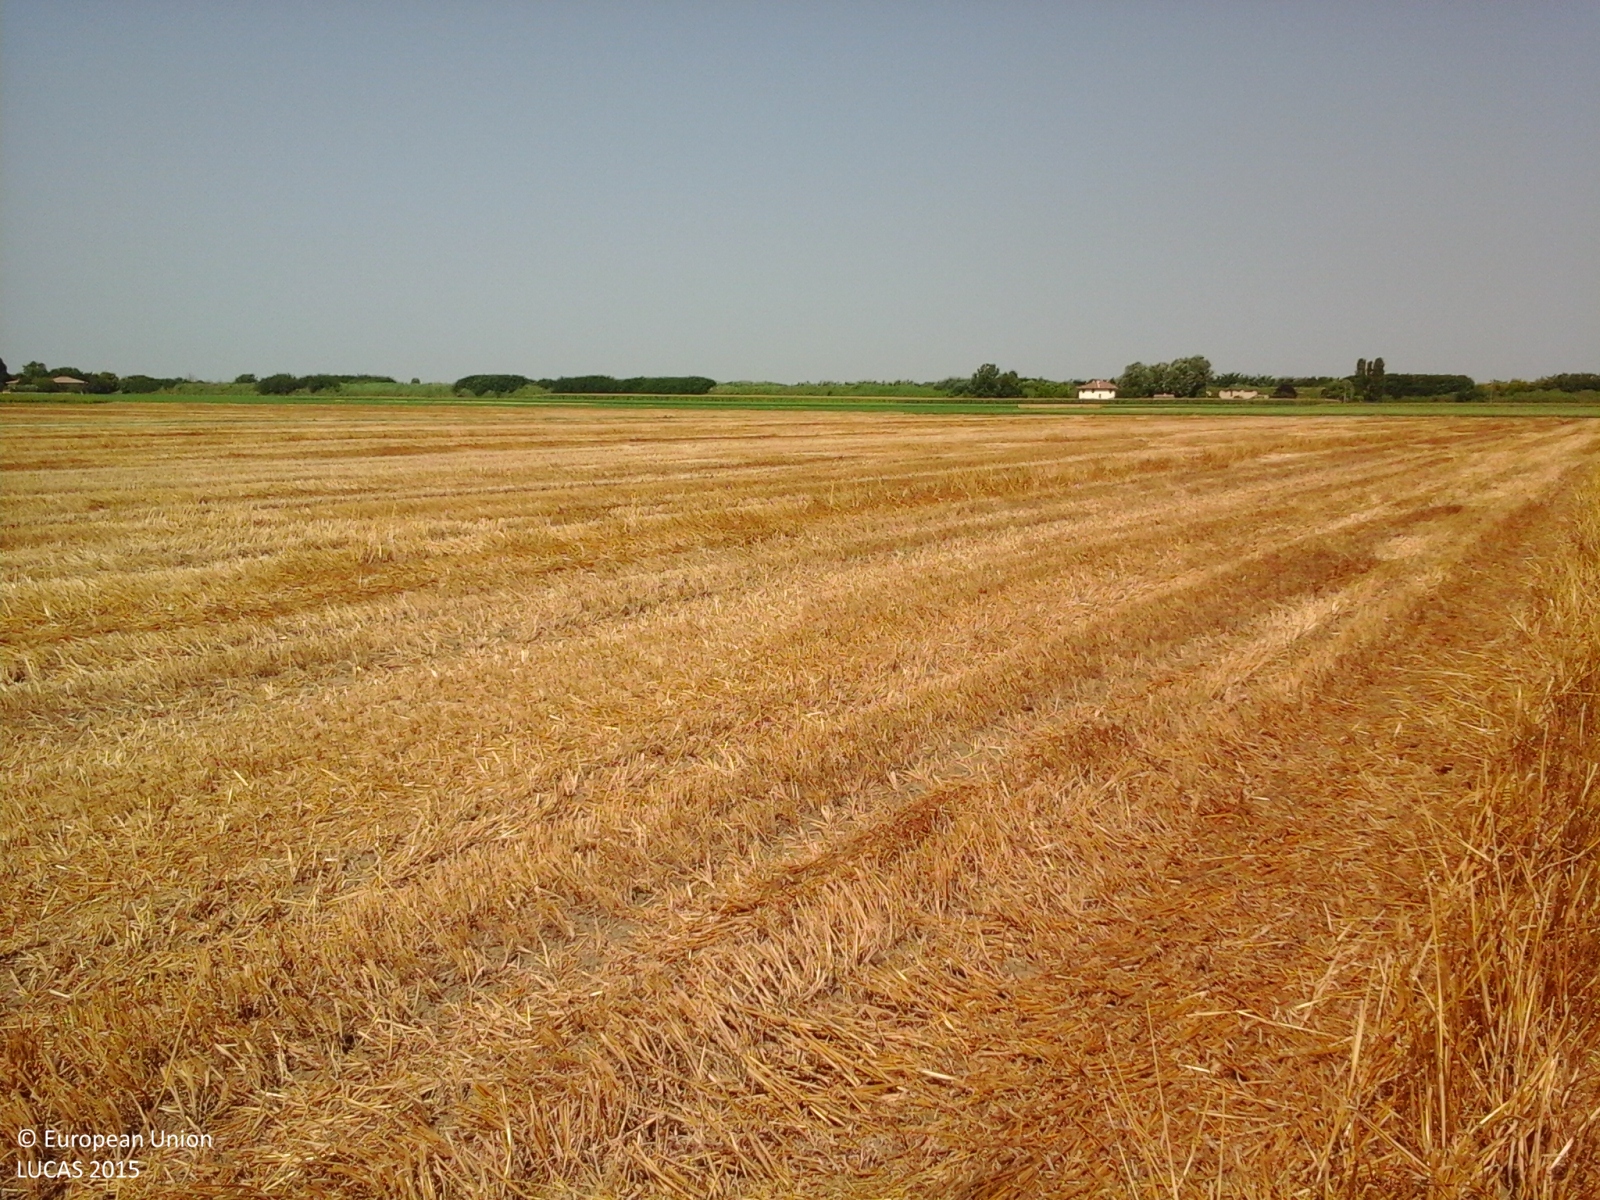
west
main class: Cropland
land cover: Common wheat
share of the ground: > 75 %
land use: Agriculture (excluding fallow land and kitchen gardens)
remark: Harvested field
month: July
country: IT
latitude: 44.5183
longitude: 11.6195
